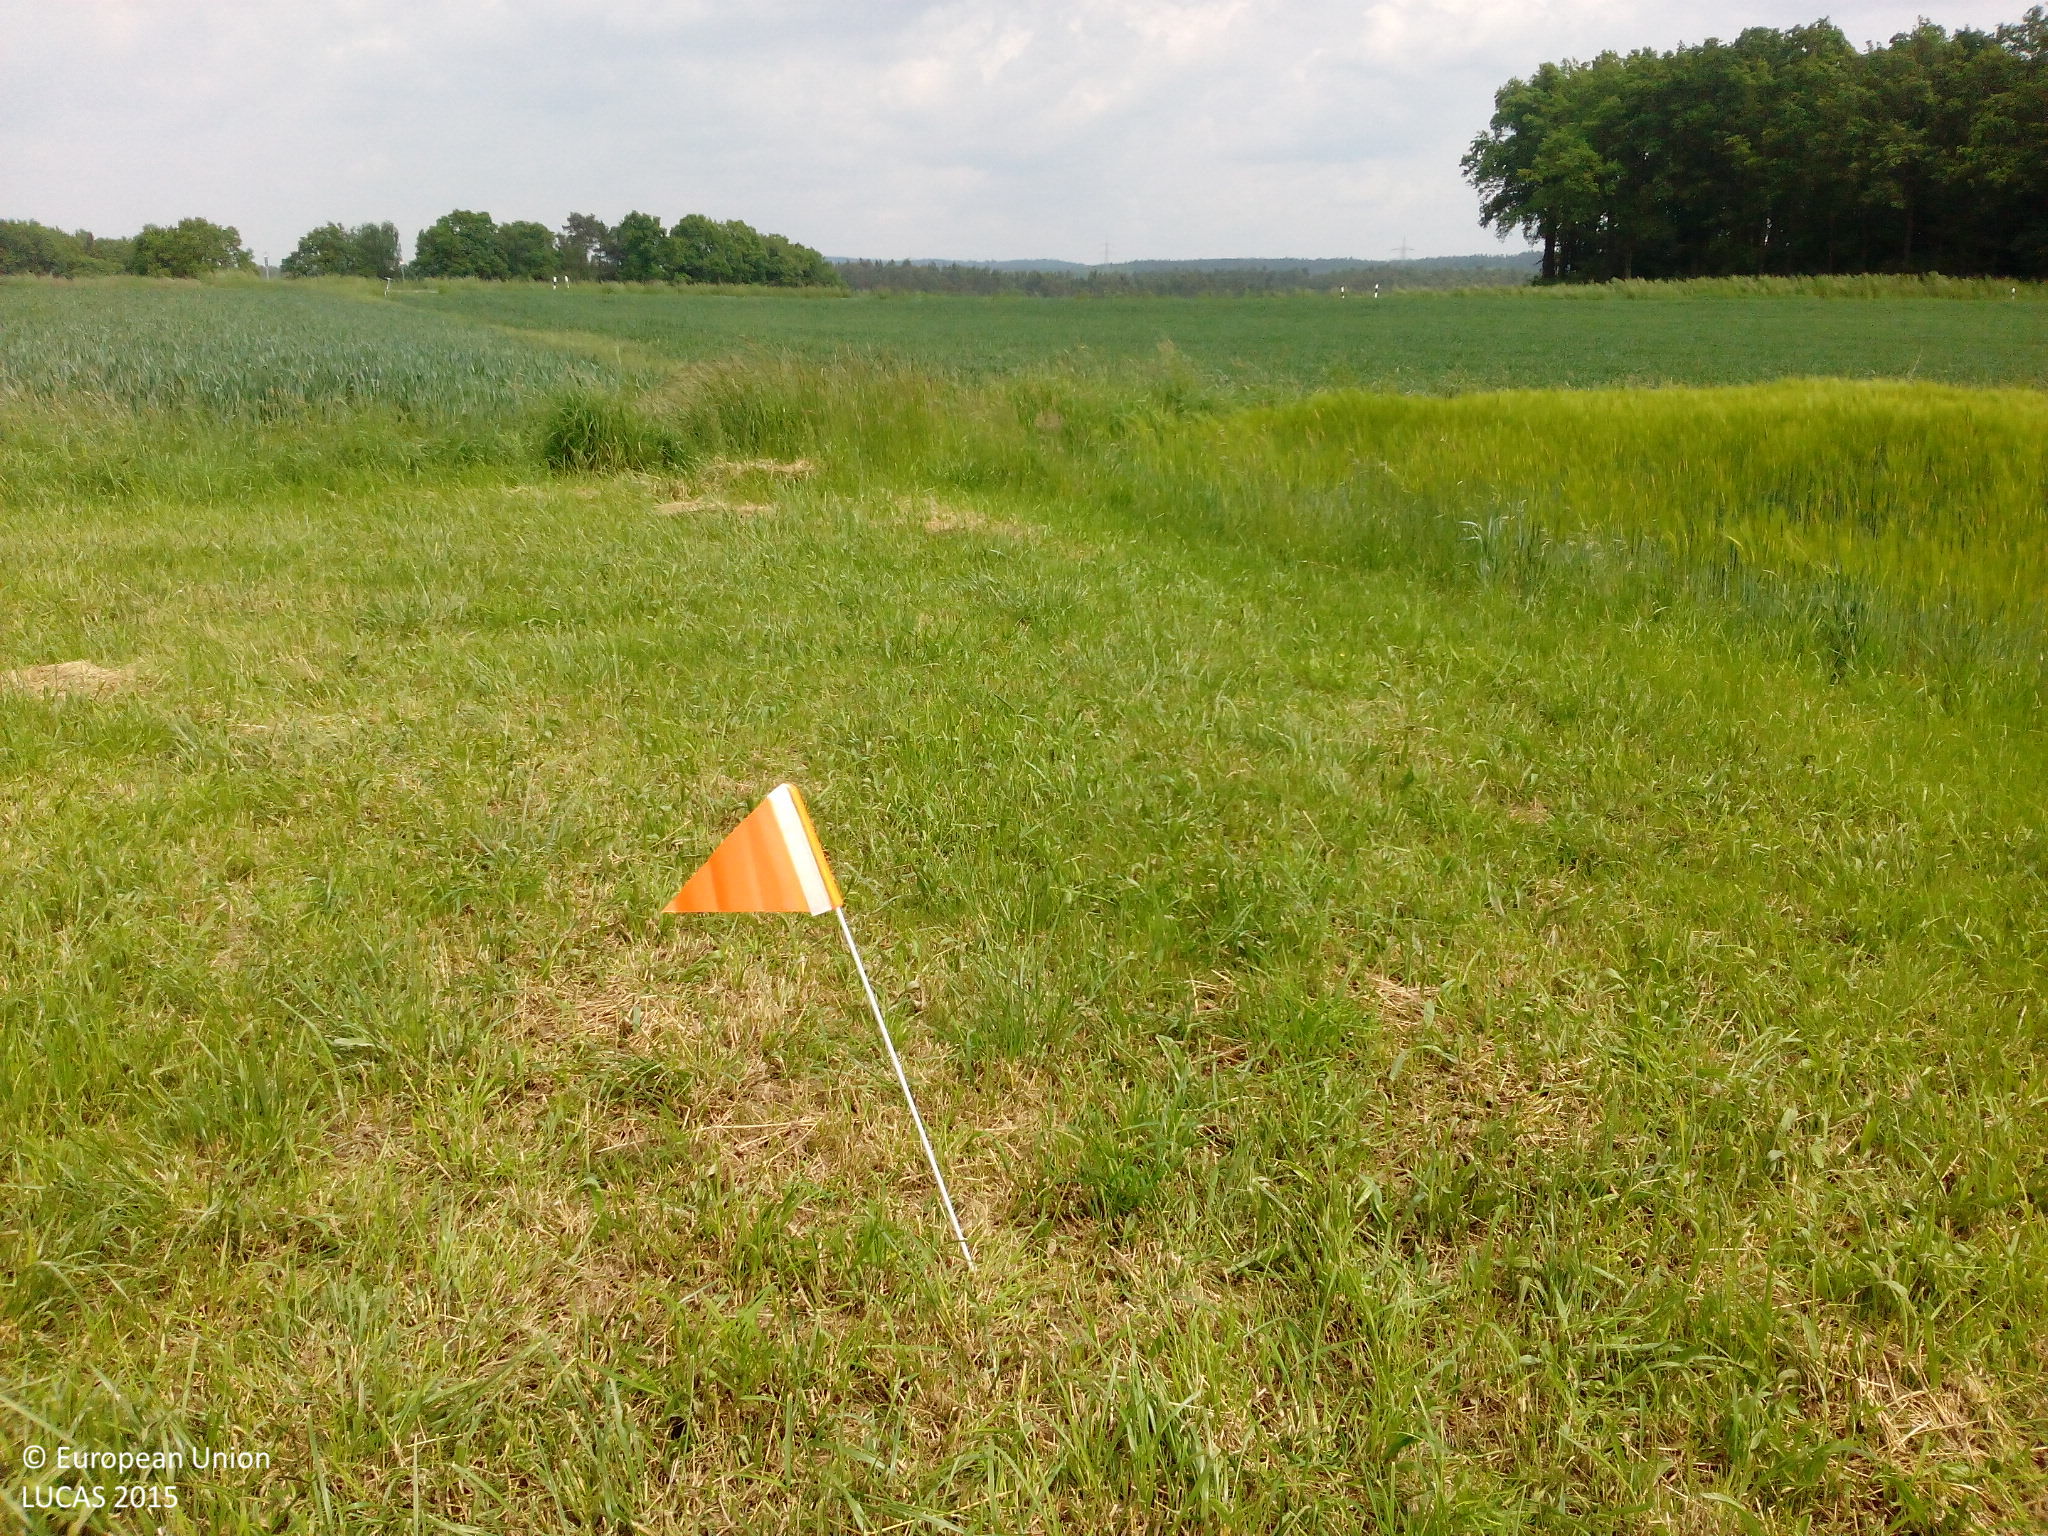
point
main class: Grassland
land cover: Grassland without tree/shrub cover
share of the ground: > 75 %
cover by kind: herbaceous plants 95 %, unconsolidated bare surface 5 %
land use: Agriculture (excluding fallow land and kitchen gardens)
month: May
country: DE
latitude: 49.1395
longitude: 12.0966
